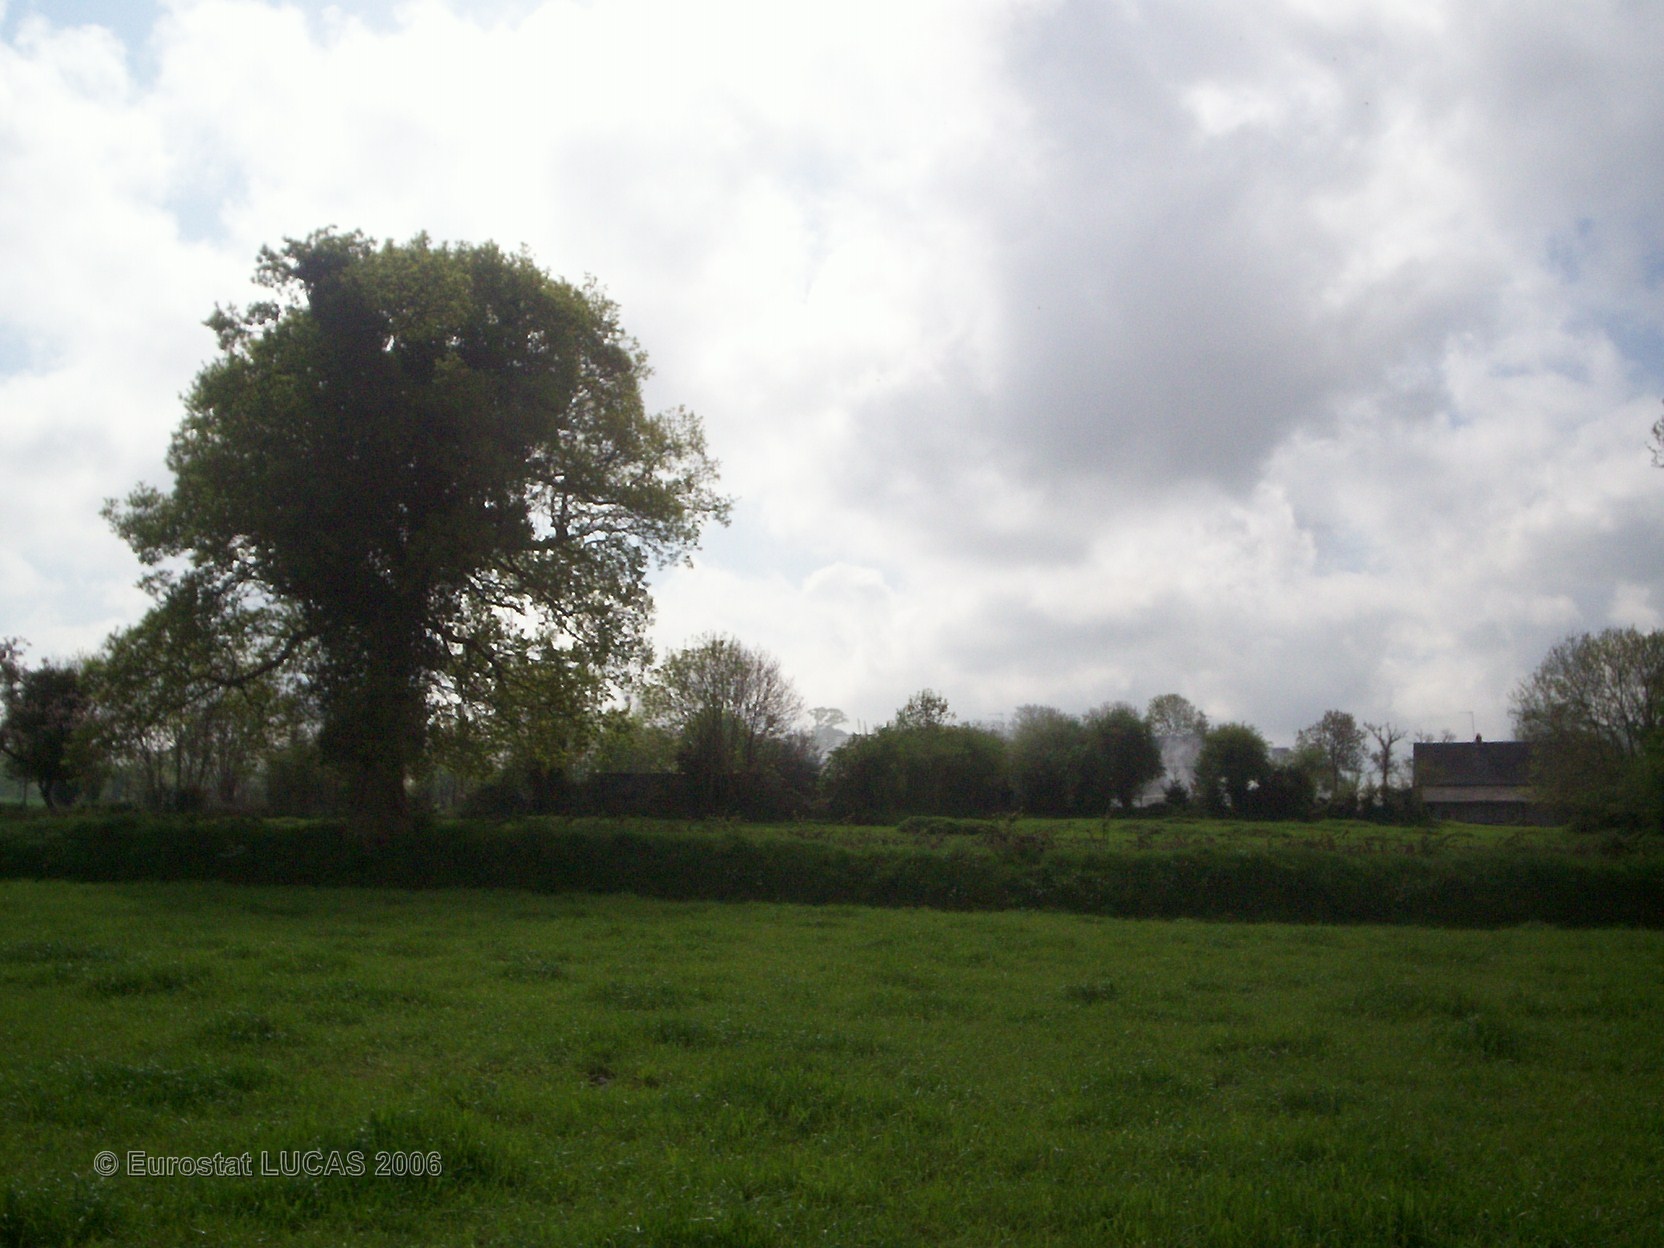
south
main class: Grassland
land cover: Grassland without tree/shrub cover
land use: Agriculture (excluding fallow land and kitchen gardens)
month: May
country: FR
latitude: 48.9391
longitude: -1.3918
